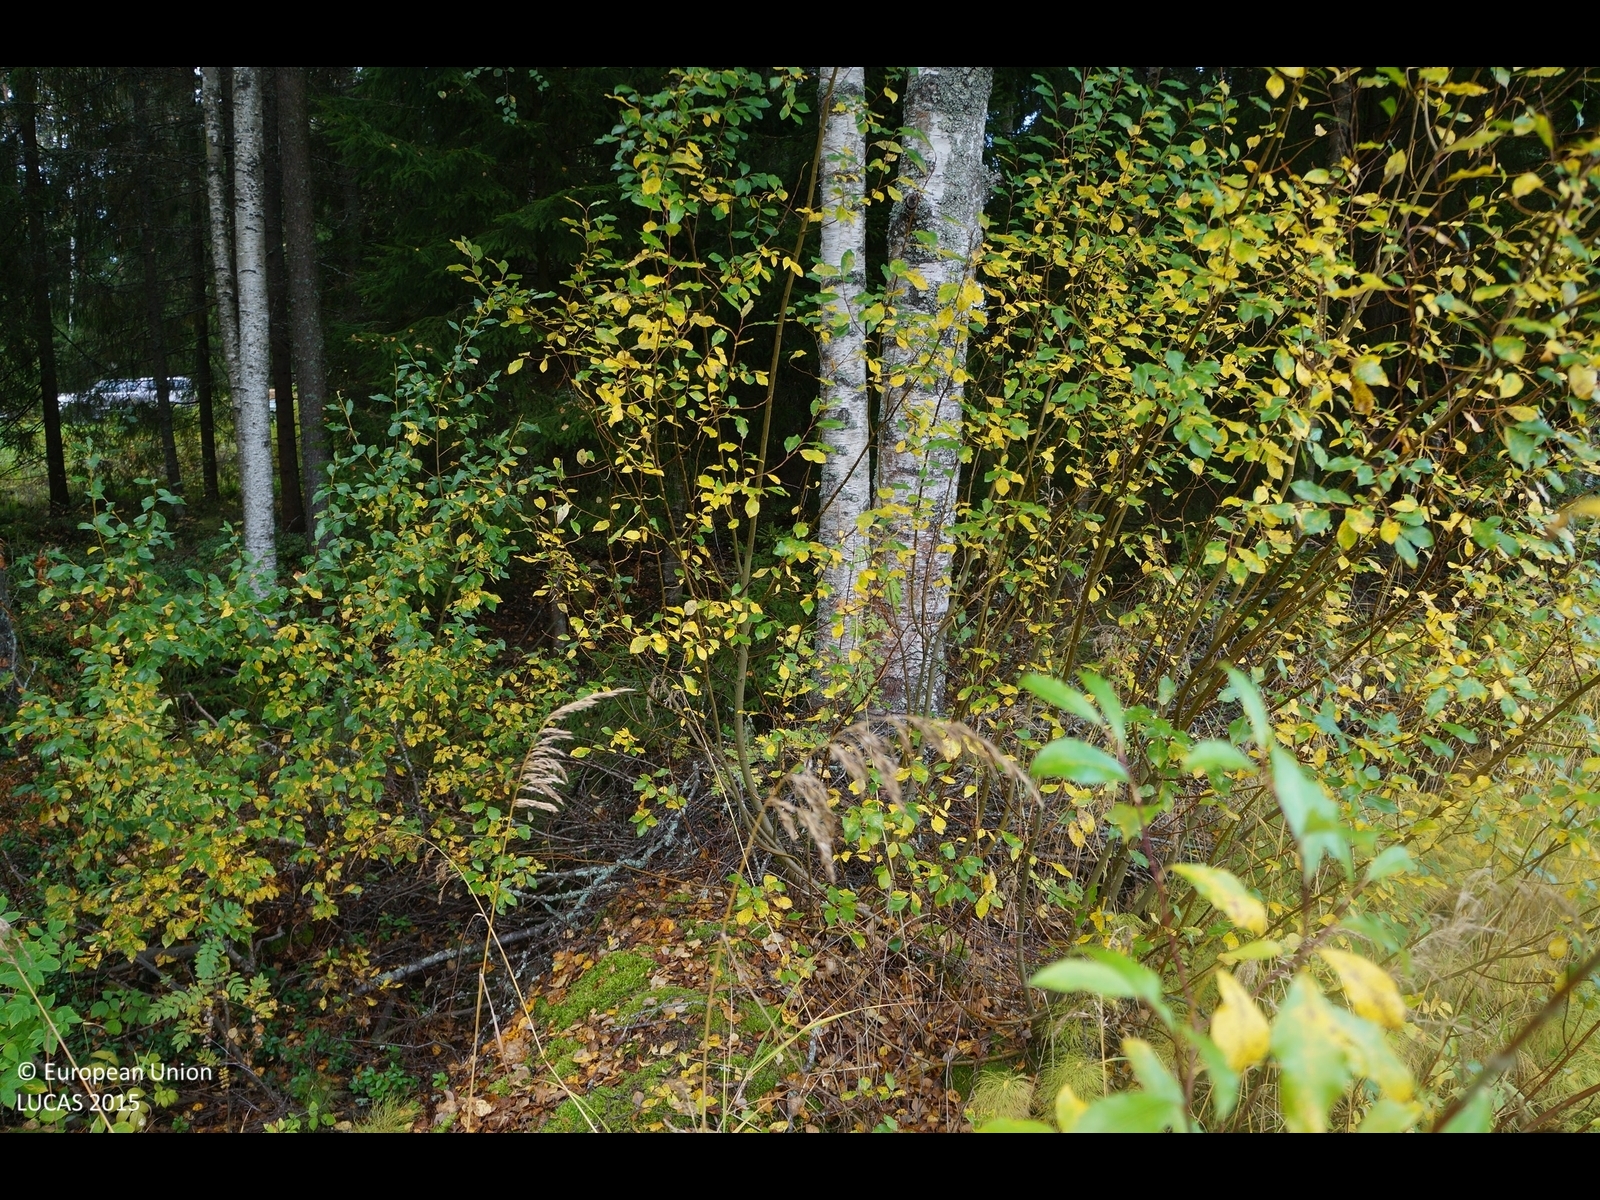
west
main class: Cropland
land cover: Oats
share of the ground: > 75 %
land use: Agriculture (excluding fallow land and kitchen gardens)
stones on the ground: < 10 %
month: September
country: FI
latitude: 63.8506
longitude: 23.3362
